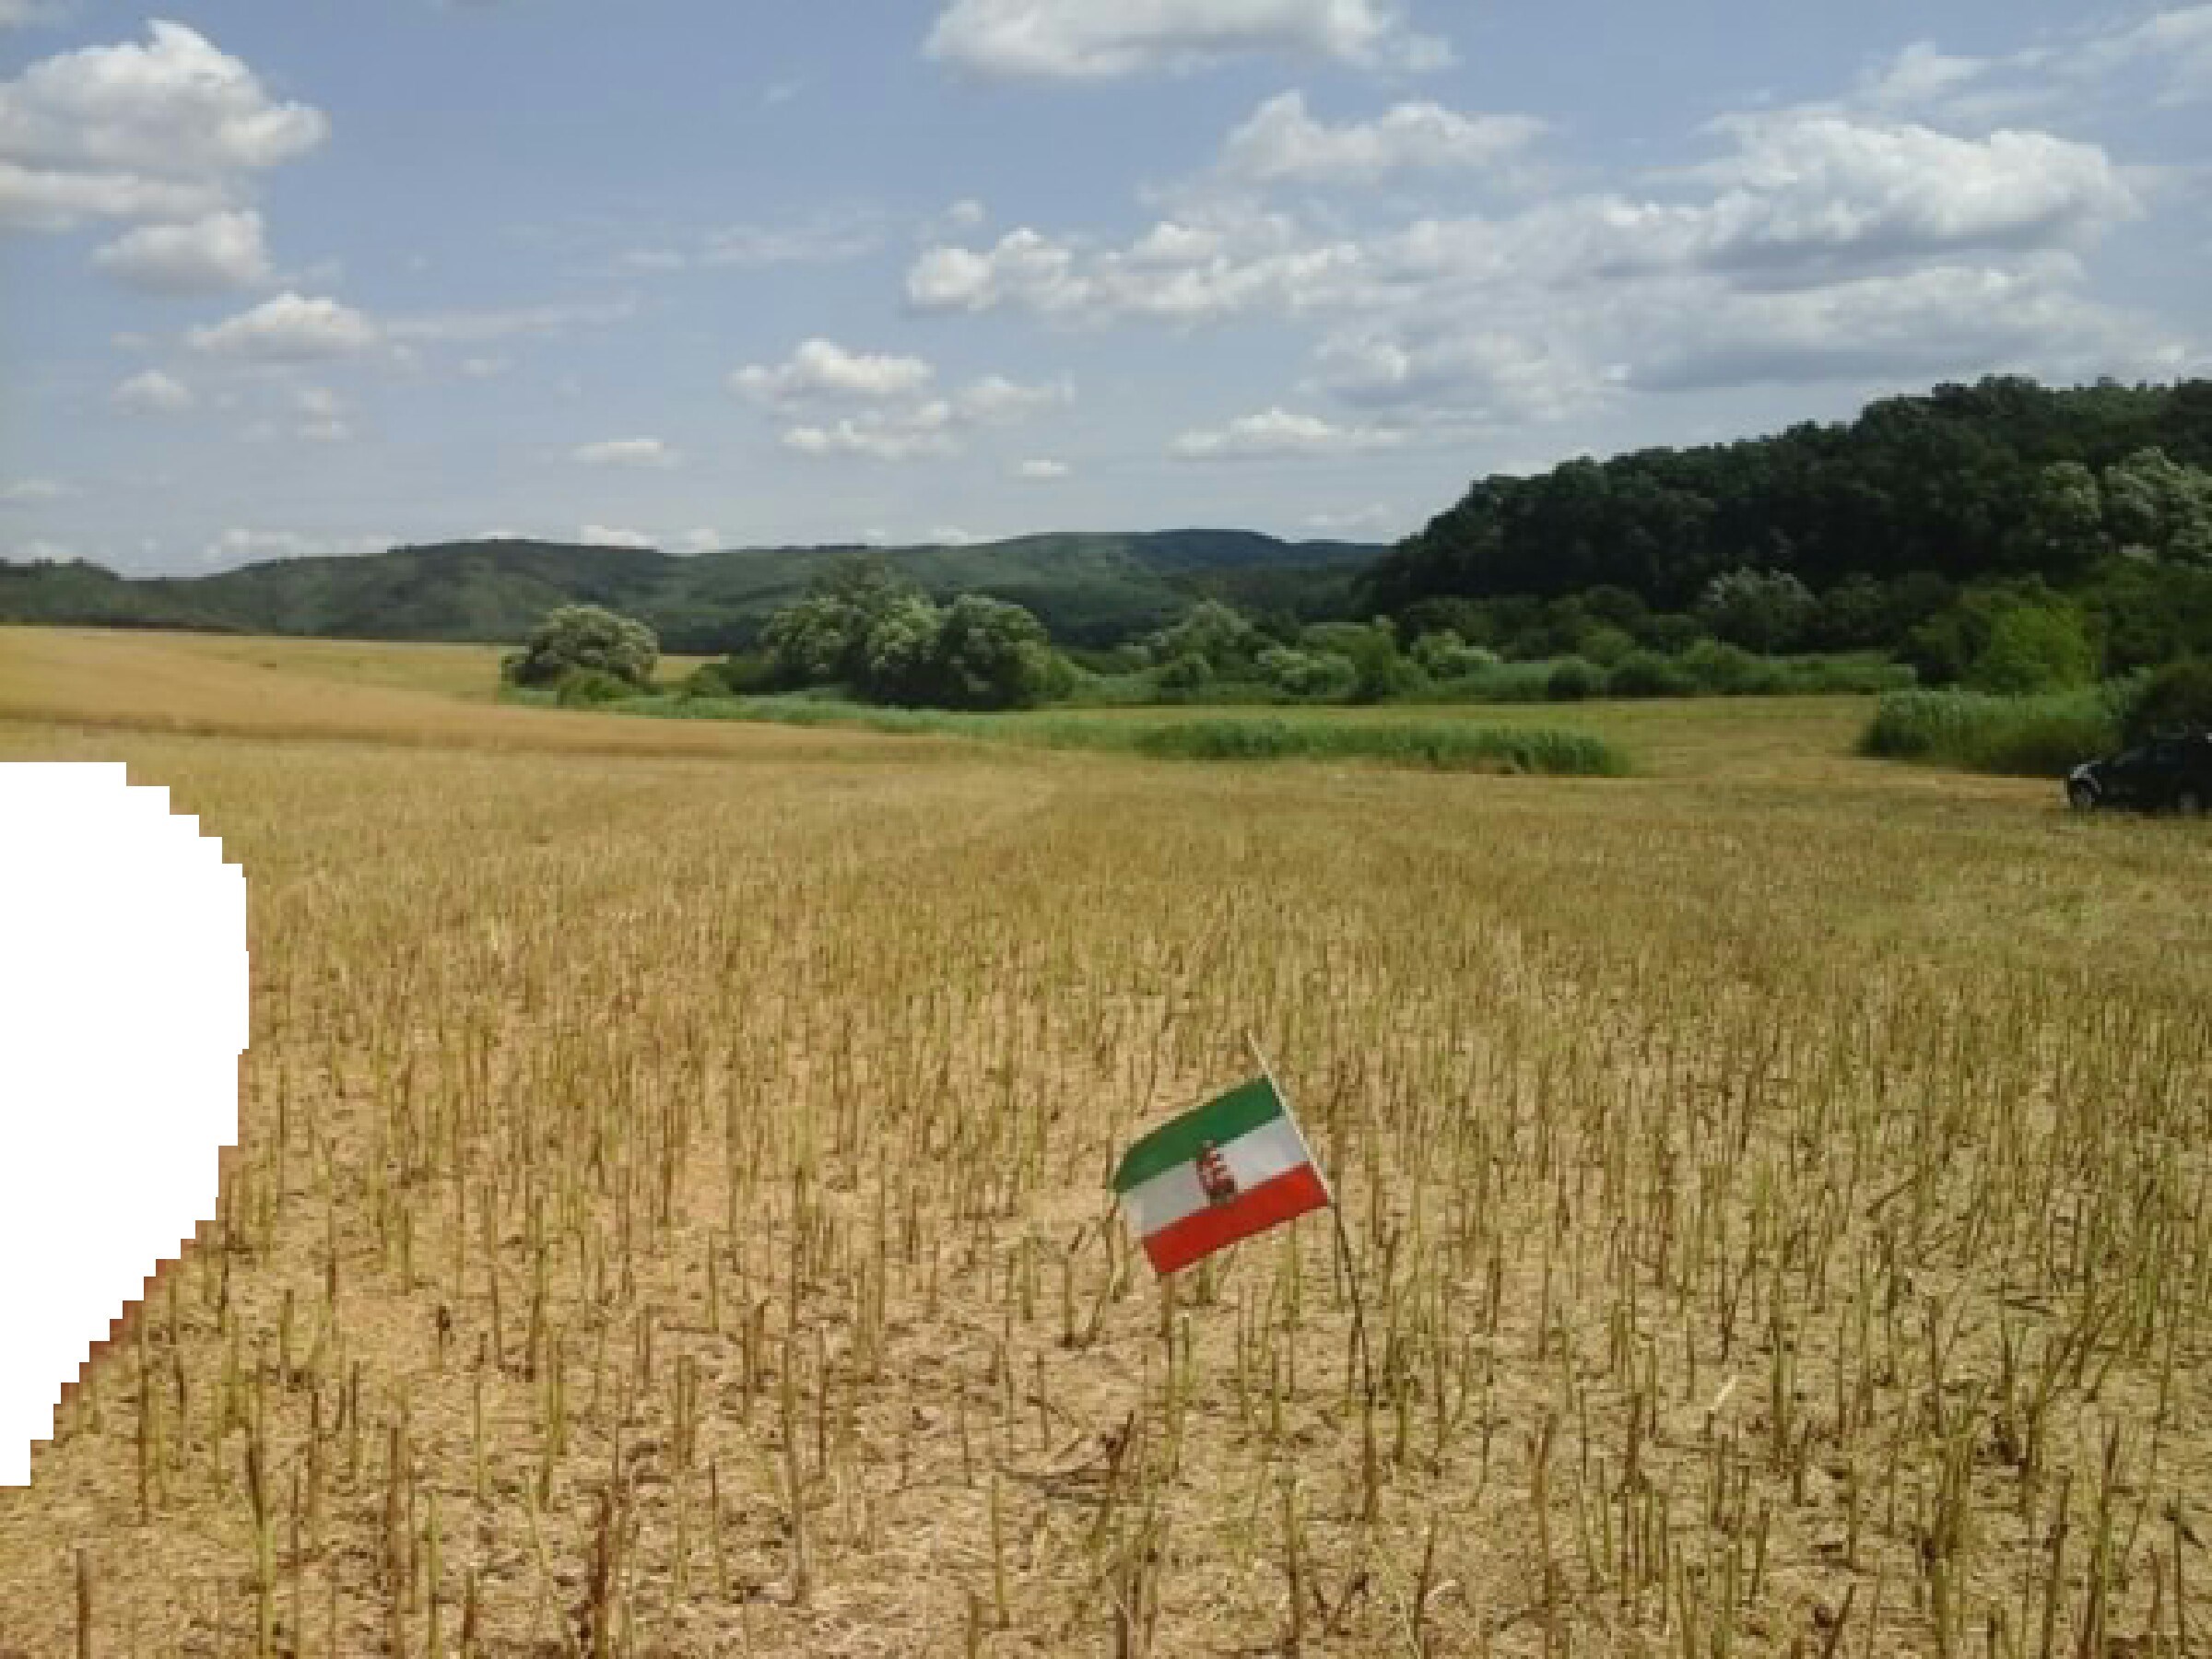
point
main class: Cropland
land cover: Rape and turnip rape
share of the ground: 10 - 25 %
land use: Agriculture (excluding fallow land and kitchen gardens)
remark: Harvested field
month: July
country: HU
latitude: 47.8783
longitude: 19.1525
